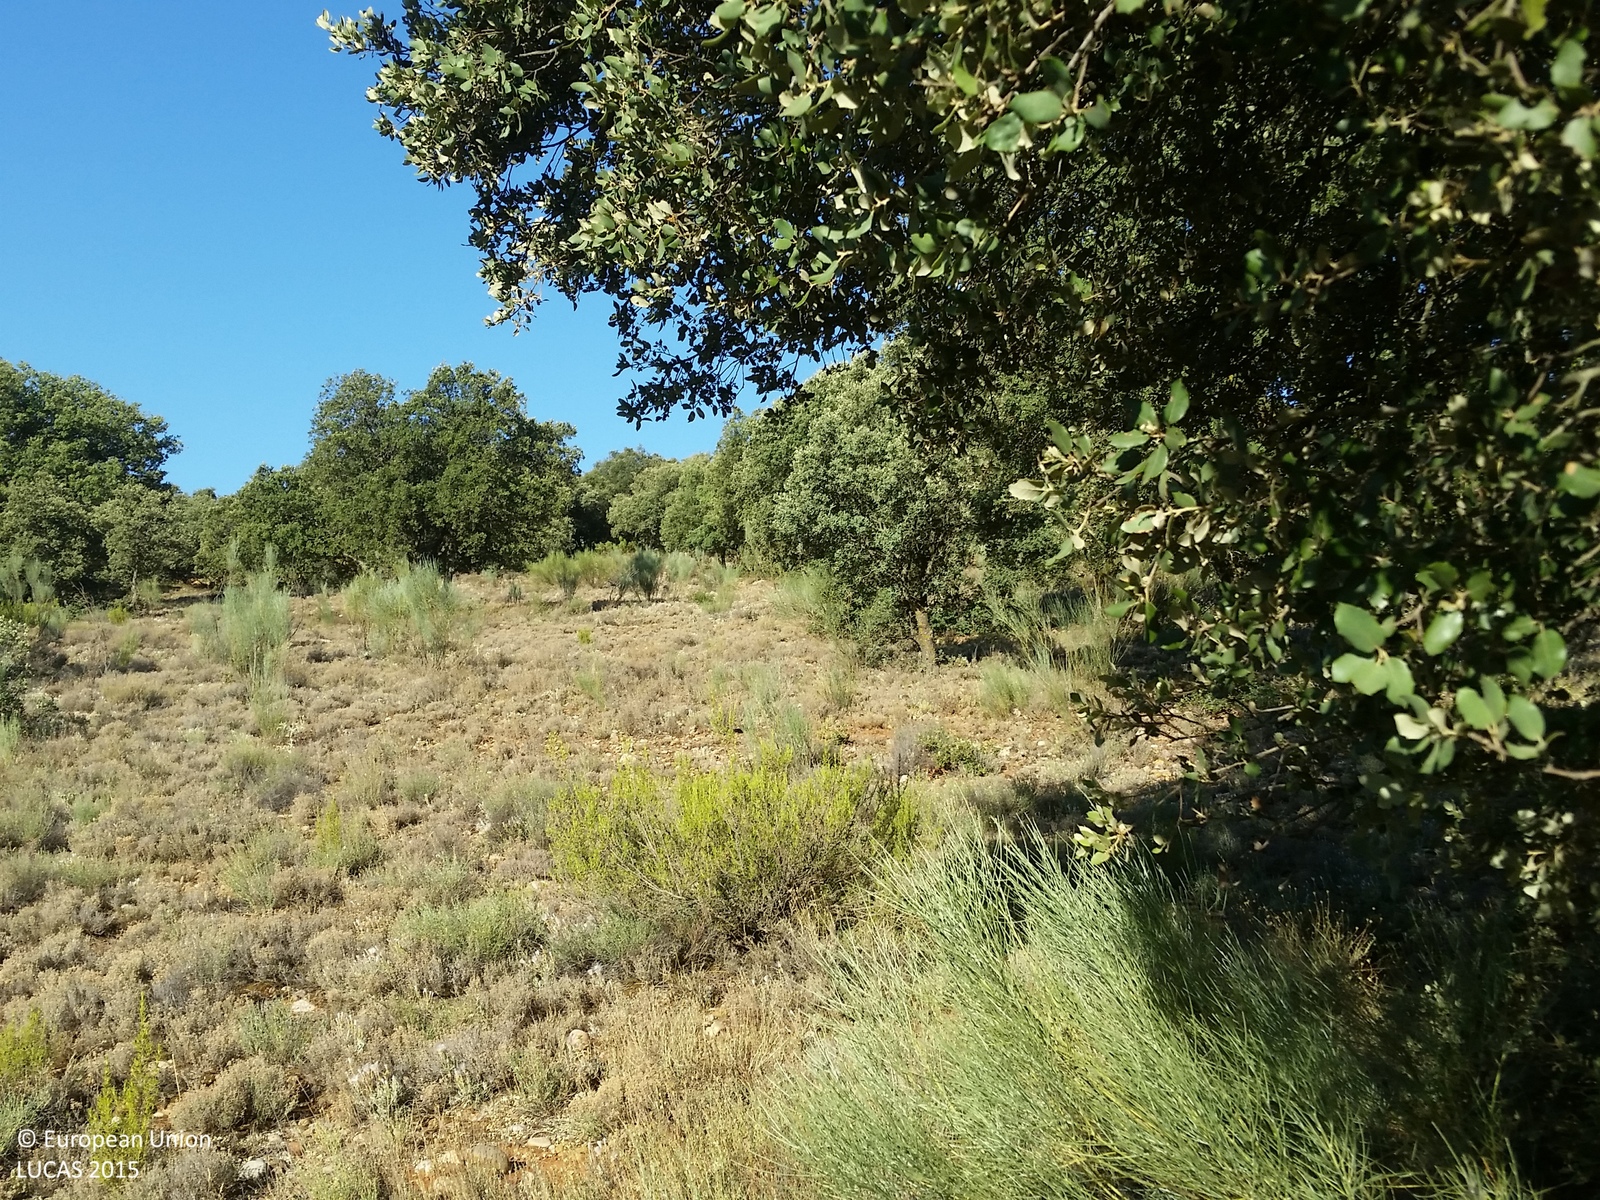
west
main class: Woodland
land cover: Broadleaved woodland
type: broadleaved evergreen forest
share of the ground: 25 - 50 %
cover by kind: broadleaved forest trees 40 %, shrubs 30 %, consolidated bare surface 20 %, herbaceous plants 10 %
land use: Semi-natural and natural areas not in use
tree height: < 5 m
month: July
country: ES
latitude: 38.9729
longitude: -2.4823
